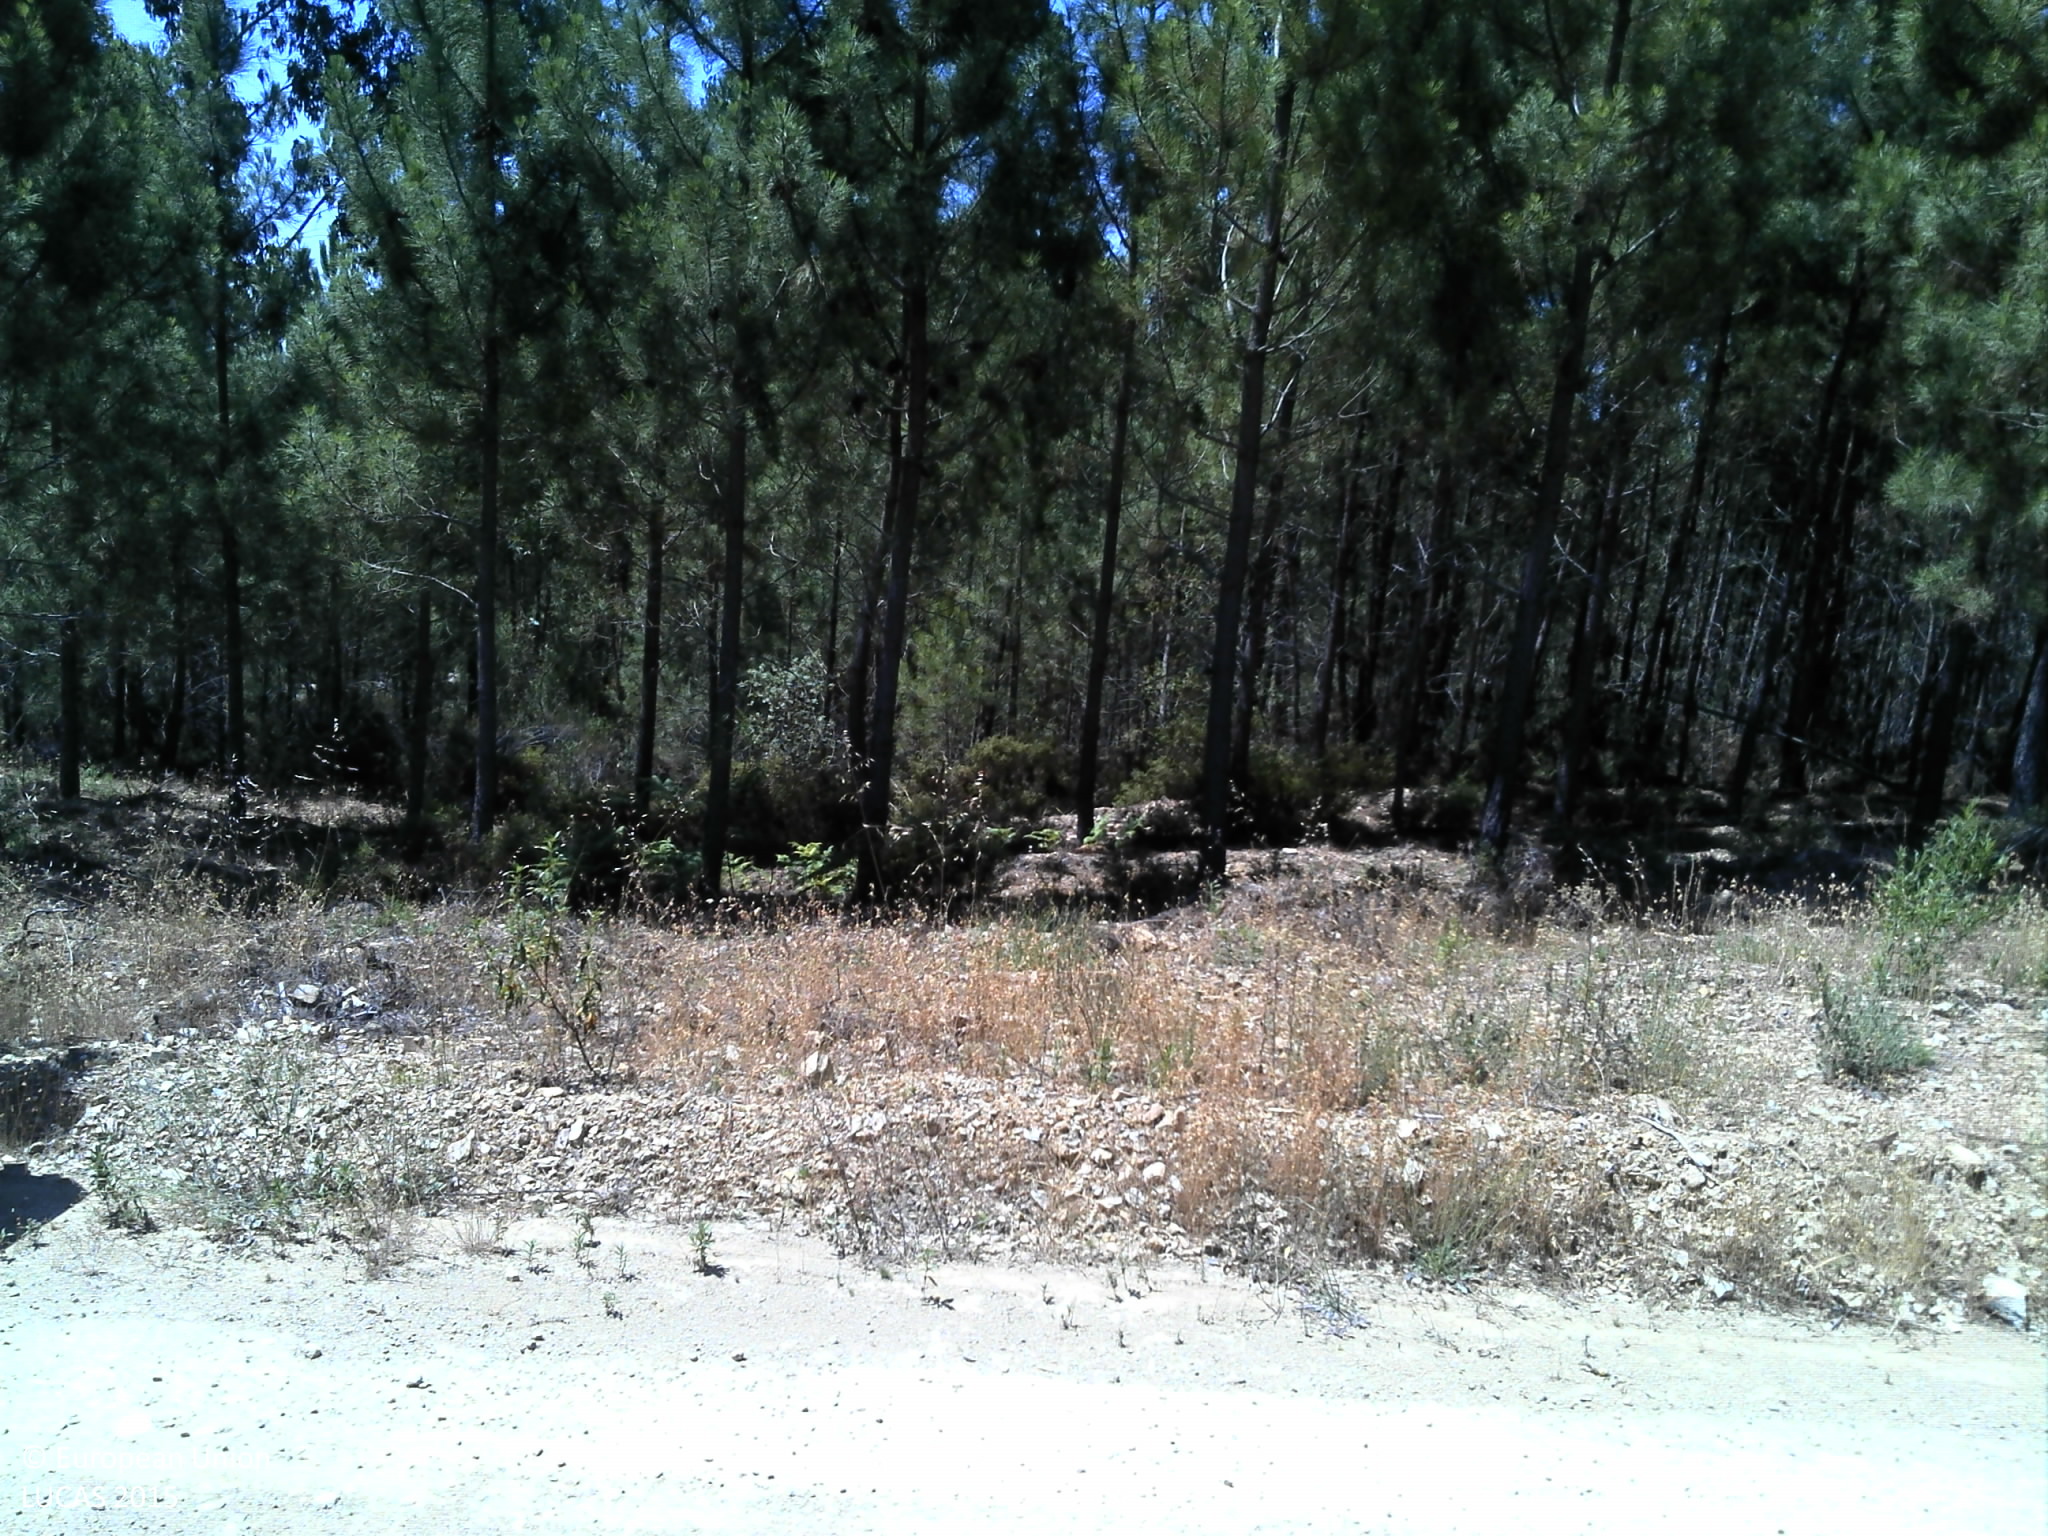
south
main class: Woodland
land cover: Pine dominated coniferous woodland
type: coniferous forest of the mediterranean region
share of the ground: 10 - 25 %
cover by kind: unconsolidated bare surface 60 %, shrubs 30 %, coniferous forest trees 10 %
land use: Forestry
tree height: > 5 m
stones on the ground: > 50 %
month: July
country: PT
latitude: 39.7333
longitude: -7.9972
